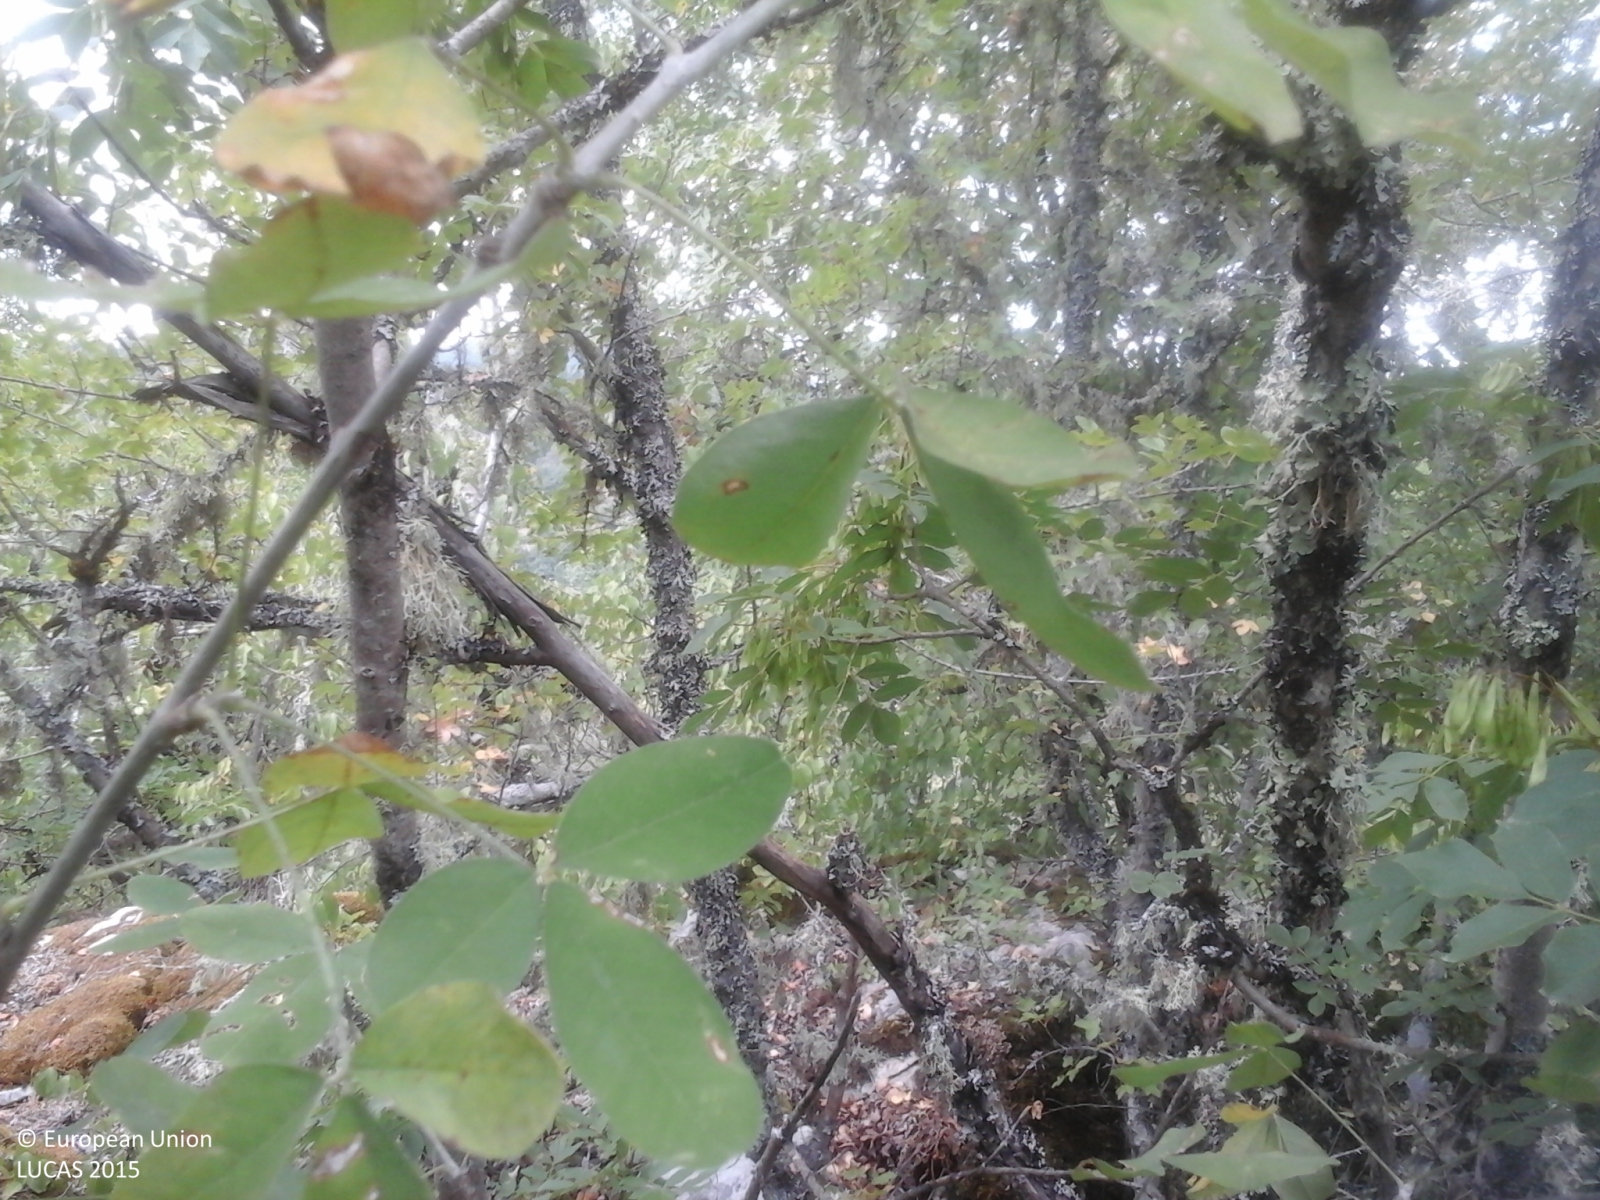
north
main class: Woodland
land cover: Broadleaved woodland
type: thermophilous deciduous forest
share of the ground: > 75 %
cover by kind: broadleaved forest trees 90 %, shrubs 5 %, herbaceous plants 5 %
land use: Semi-natural and natural areas not in use
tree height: < 5 m
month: August
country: IT
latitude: 42.2254
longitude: 13.1516
